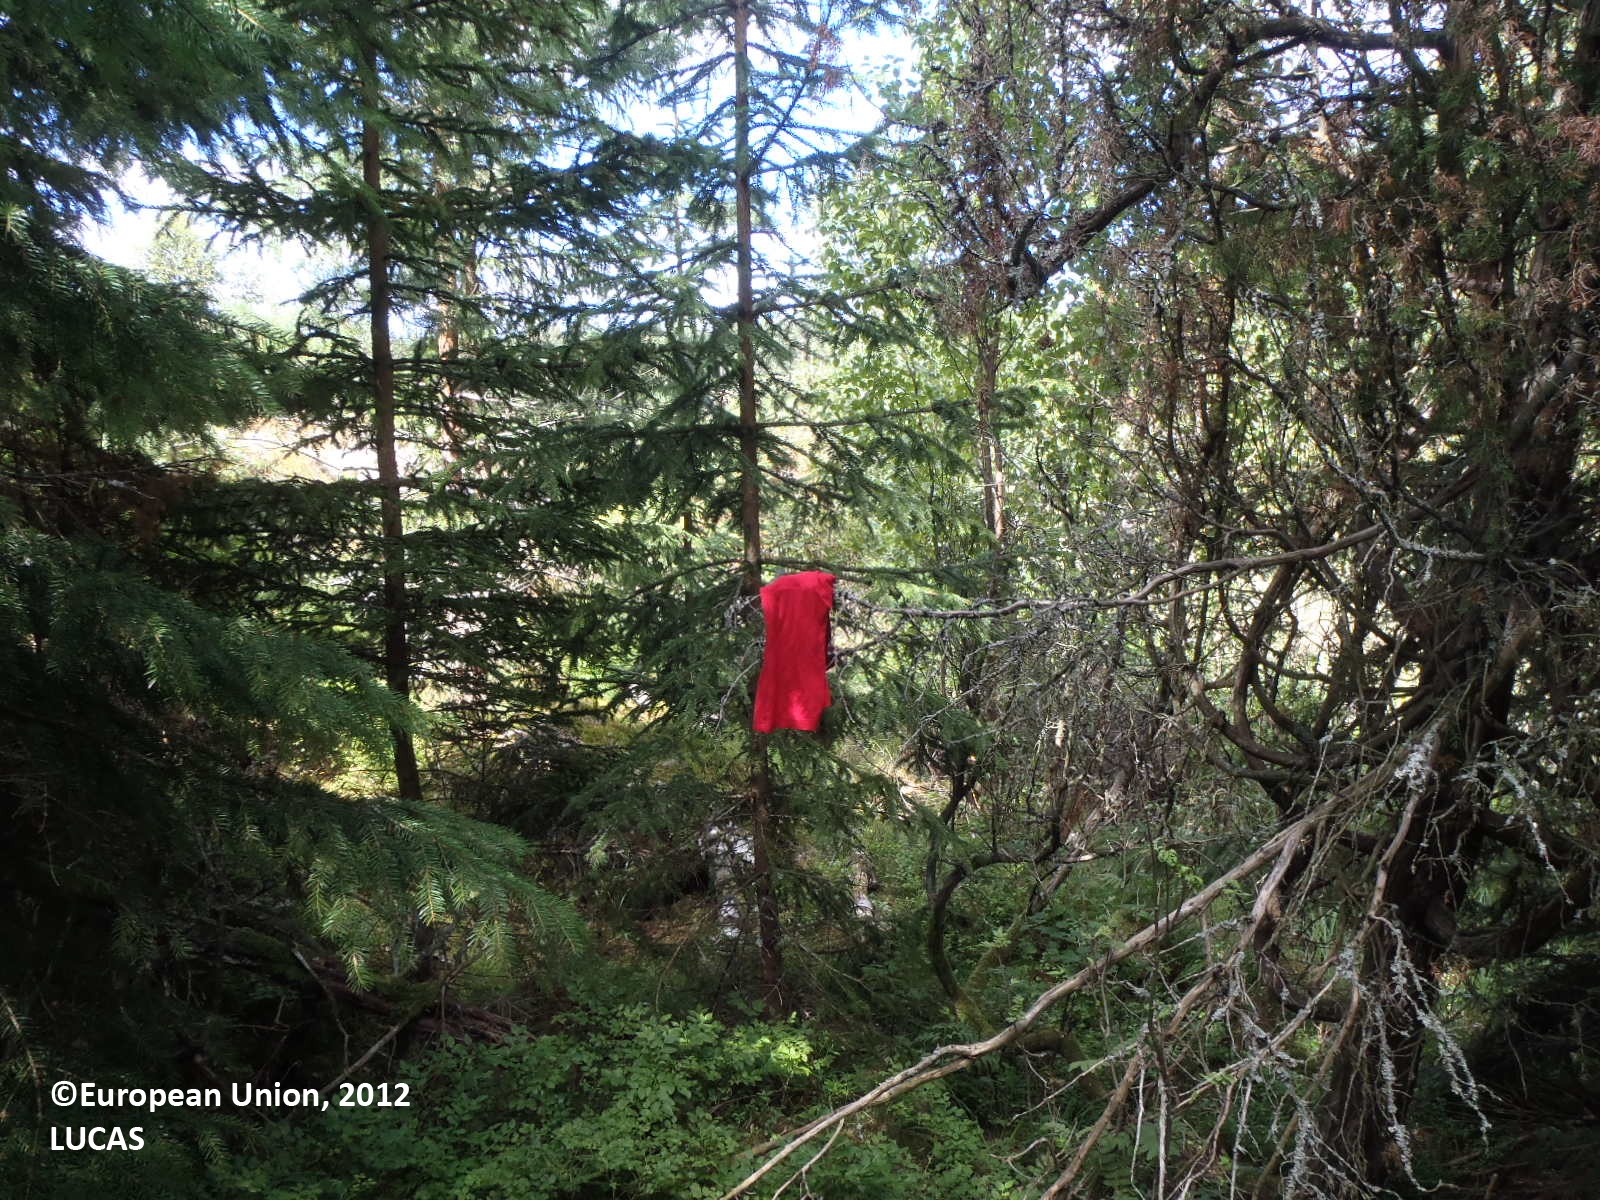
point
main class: Woodland
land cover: Spruce dominated mixed woodland
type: boreal forest
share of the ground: > 75 %
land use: Forestry
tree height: > 5 m
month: August
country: FI
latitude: 60.1224
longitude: 21.9972
